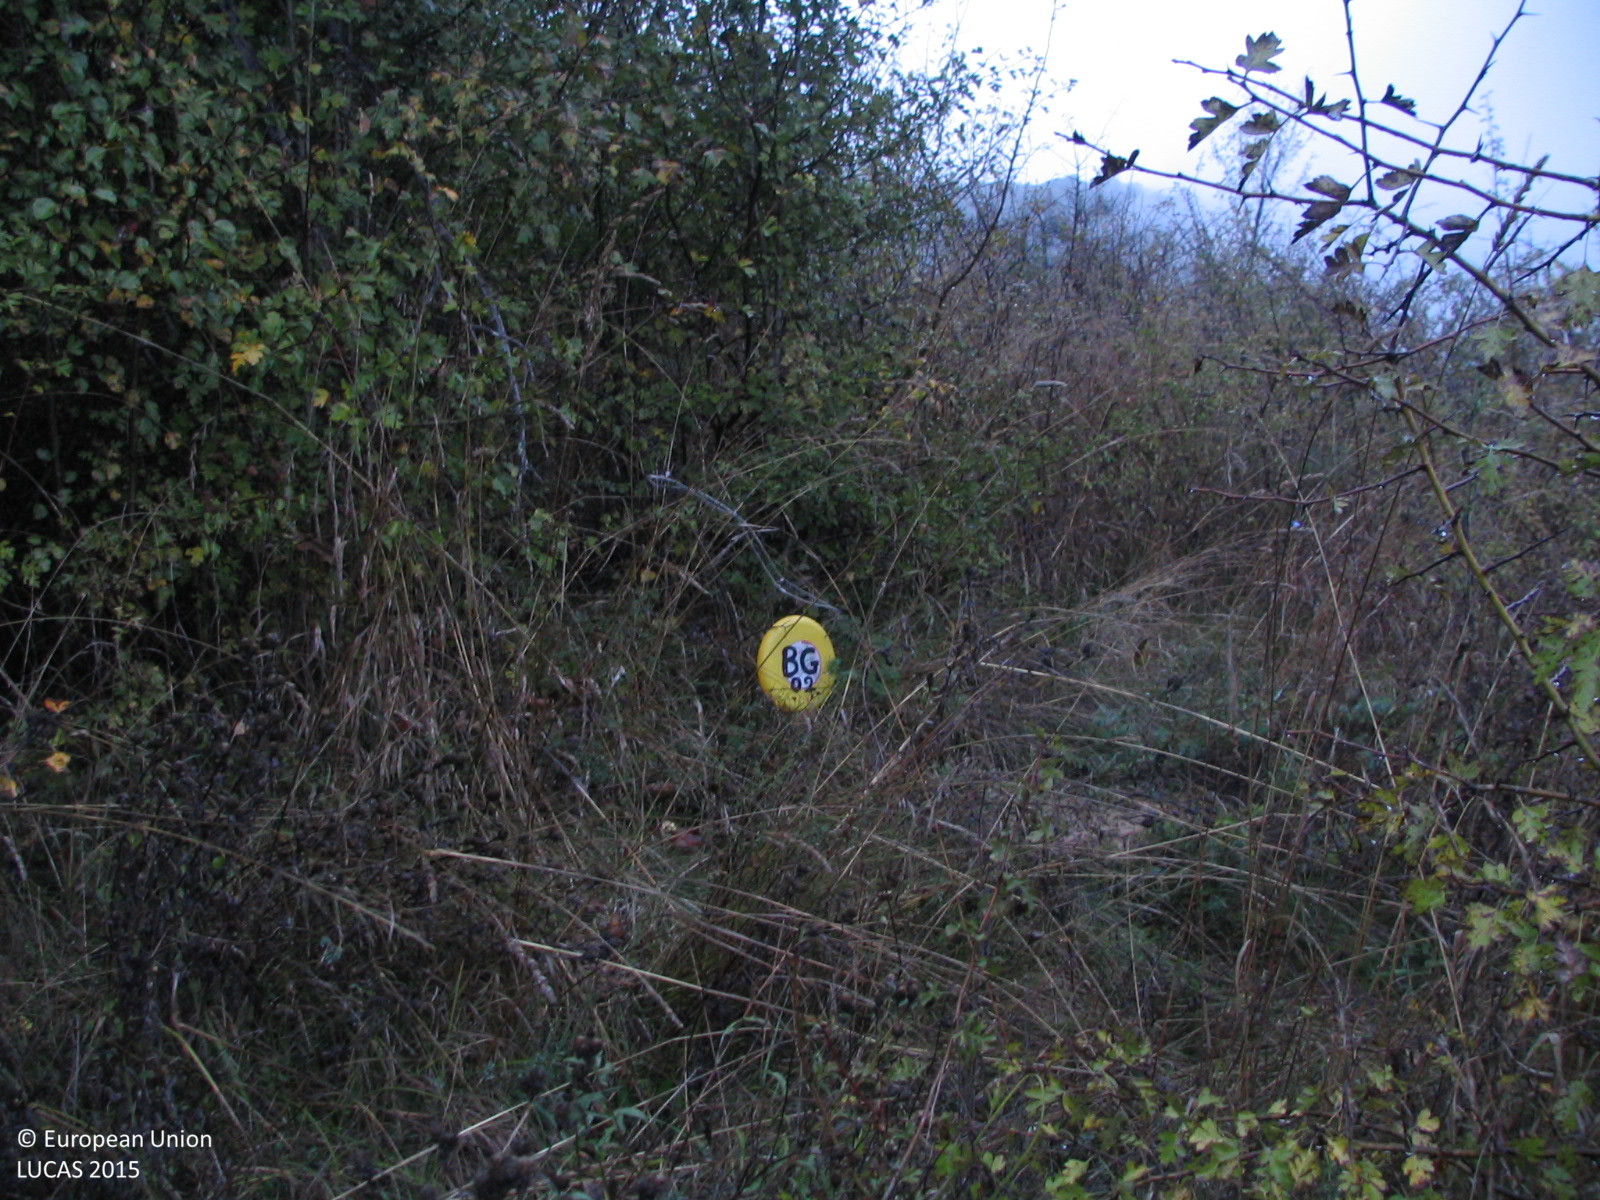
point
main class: Woodland
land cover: Broadleaved woodland
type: mesophytic deciduous forest
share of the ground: 25 - 50 %
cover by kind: shrubs 60 %, broadleaved forest trees 25 %, herbaceous plants 15 %
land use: Semi-natural and natural areas not in use
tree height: > 5 m
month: October
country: BG
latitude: 43.0046
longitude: 23.9213
